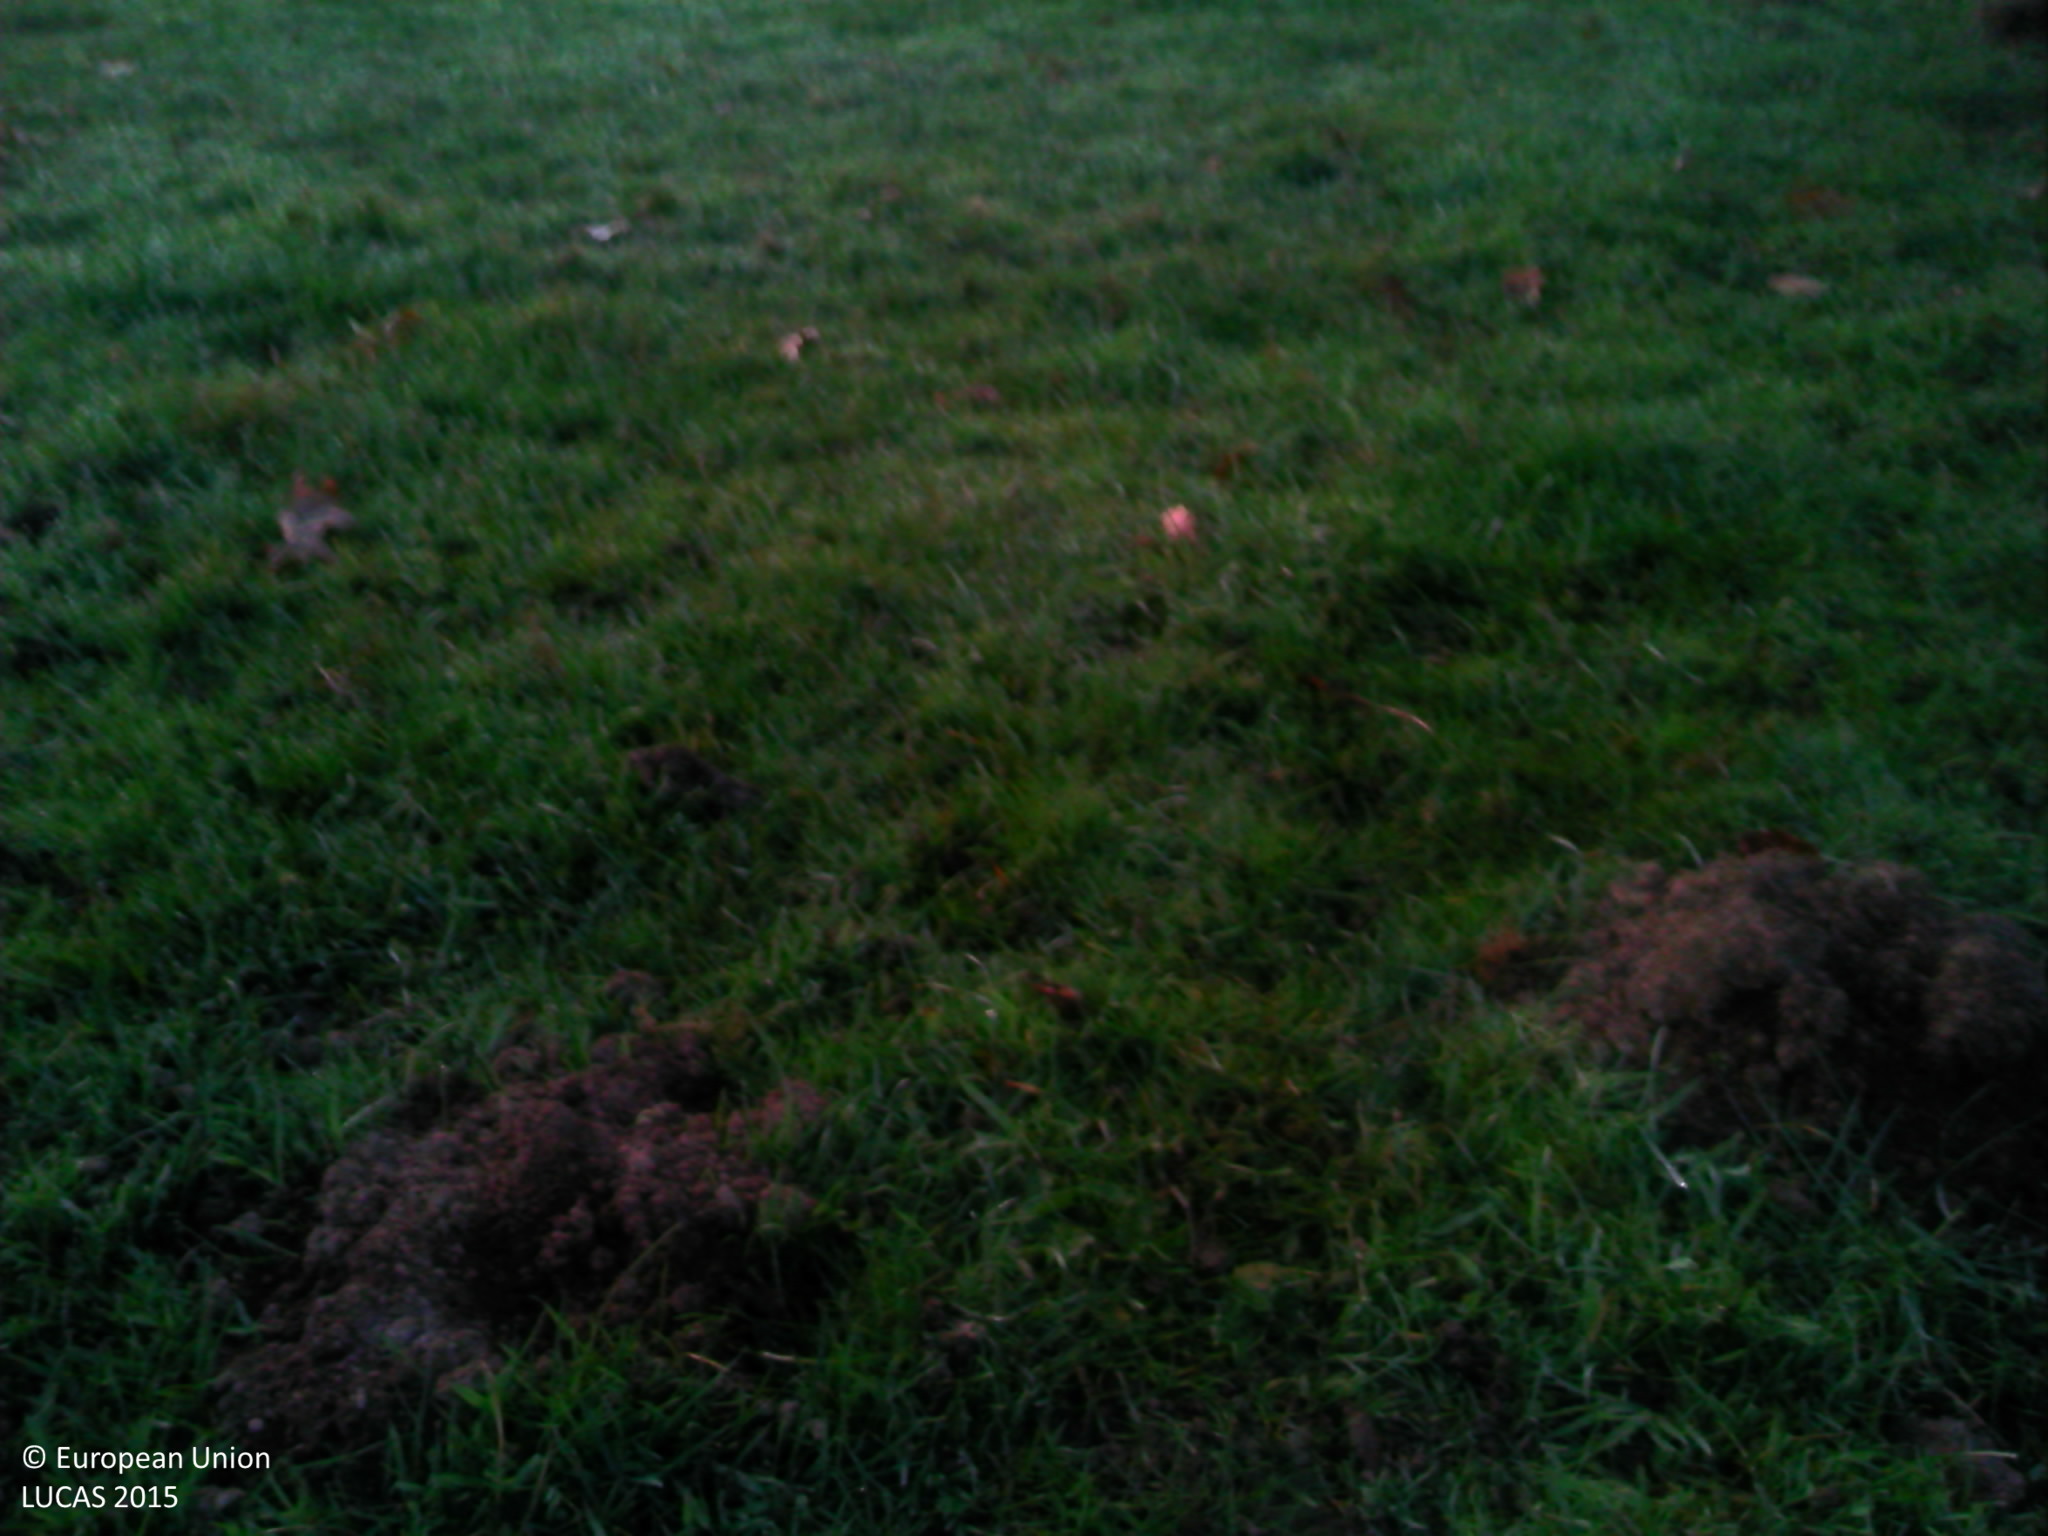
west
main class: Grassland
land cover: Grassland without tree/shrub cover
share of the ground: > 75 %
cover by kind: herbaceous plants 100 %
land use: Agriculture (excluding fallow land and kitchen gardens)
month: November
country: FR
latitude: 46.0574
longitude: 3.7058
